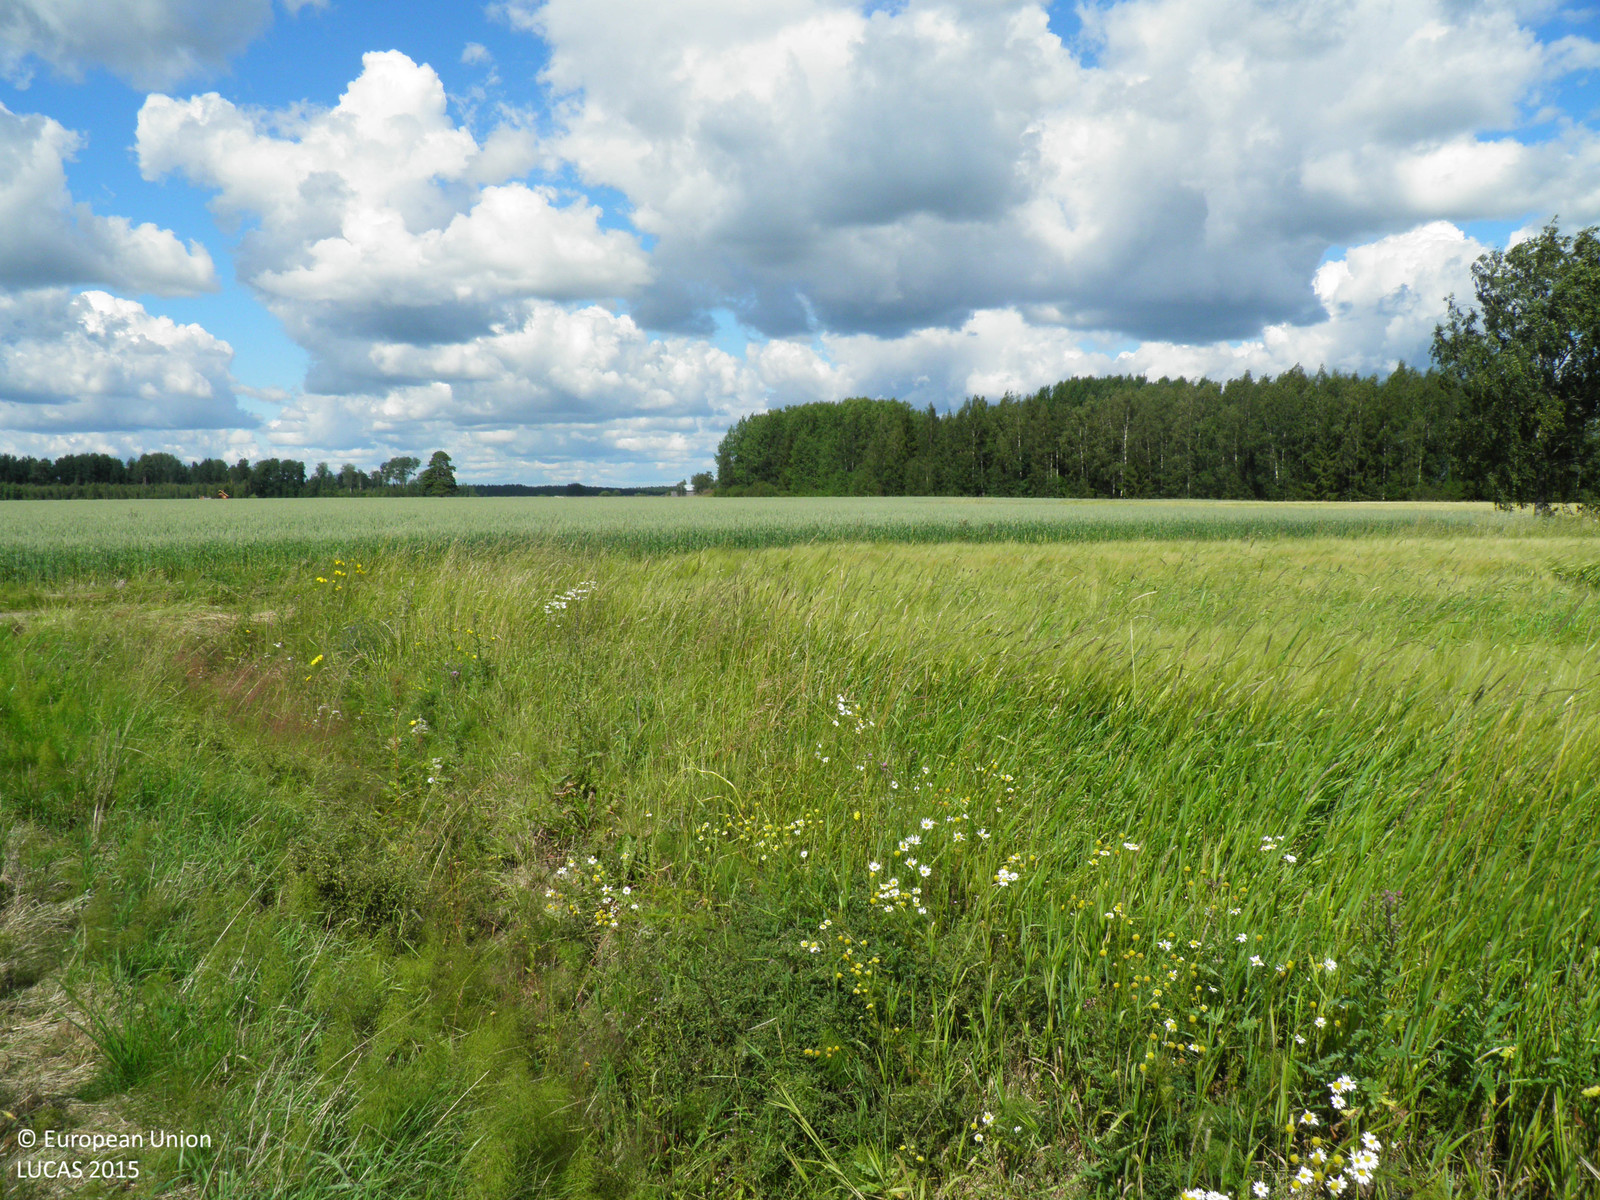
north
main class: Cropland
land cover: Barley
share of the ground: > 75 %
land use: Agriculture (excluding fallow land and kitchen gardens)
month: August
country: FI
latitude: 60.9492
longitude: 22.9792
